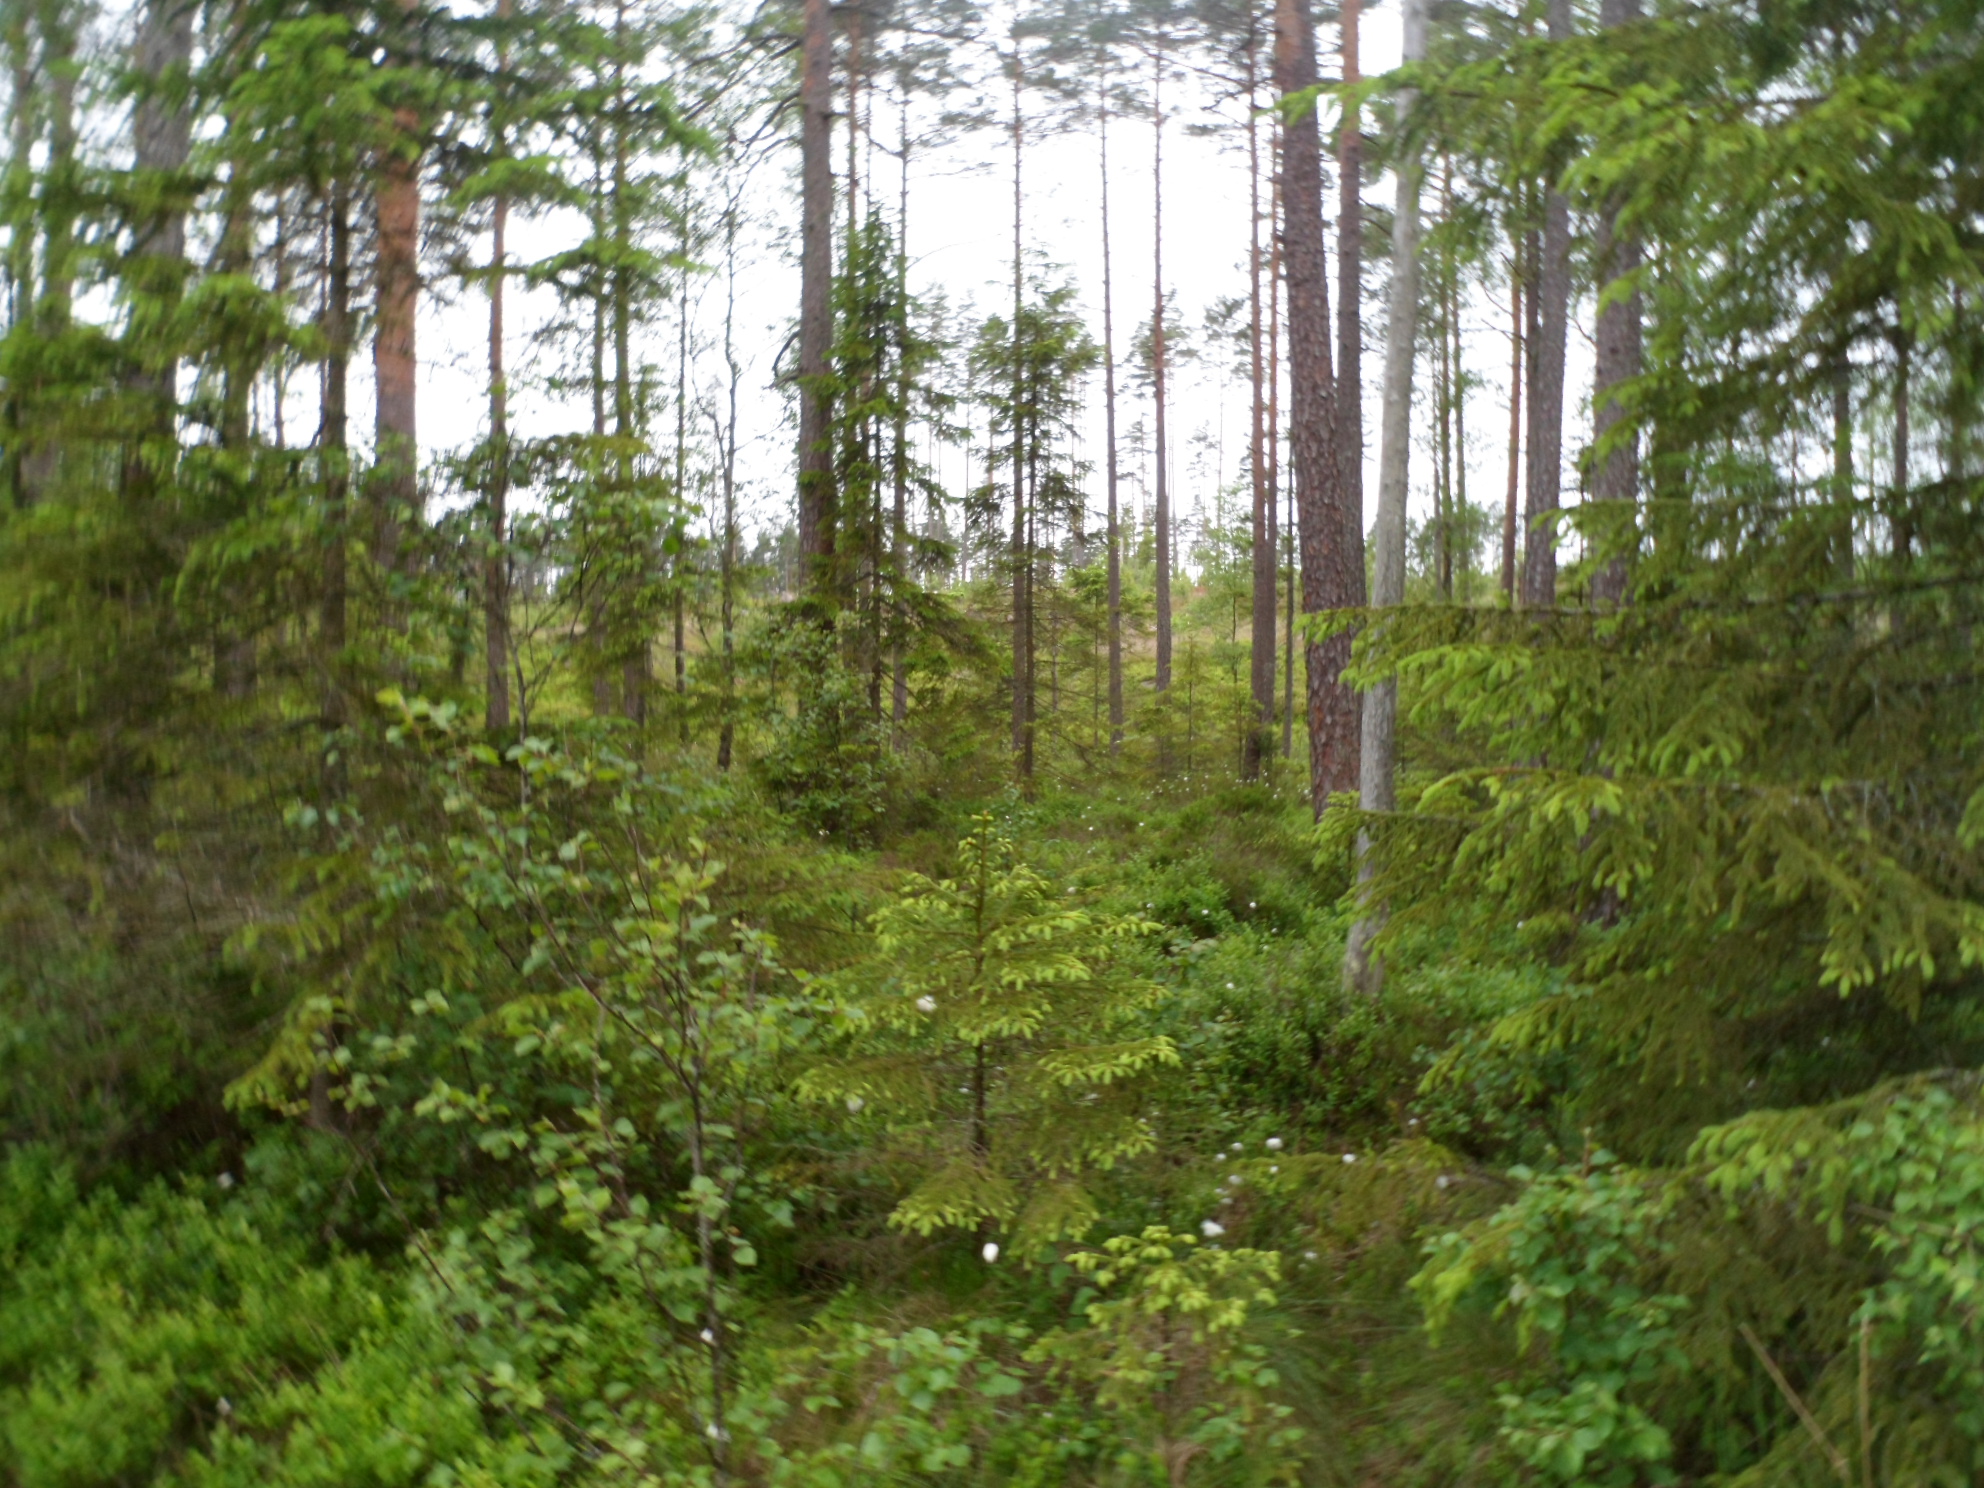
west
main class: Woodland
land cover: Spruce dominated mixed woodland
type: boreal forest
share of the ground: 50 - 75 %
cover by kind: coniferous forest trees 30 %, broadleaved forest trees 30 %, shrubs 20 %, herbaceous plants 10 %, lichens and mosses 10 %
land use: Forestry
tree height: > 5 m
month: June
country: SE
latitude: 57.0506
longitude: 15.3222
